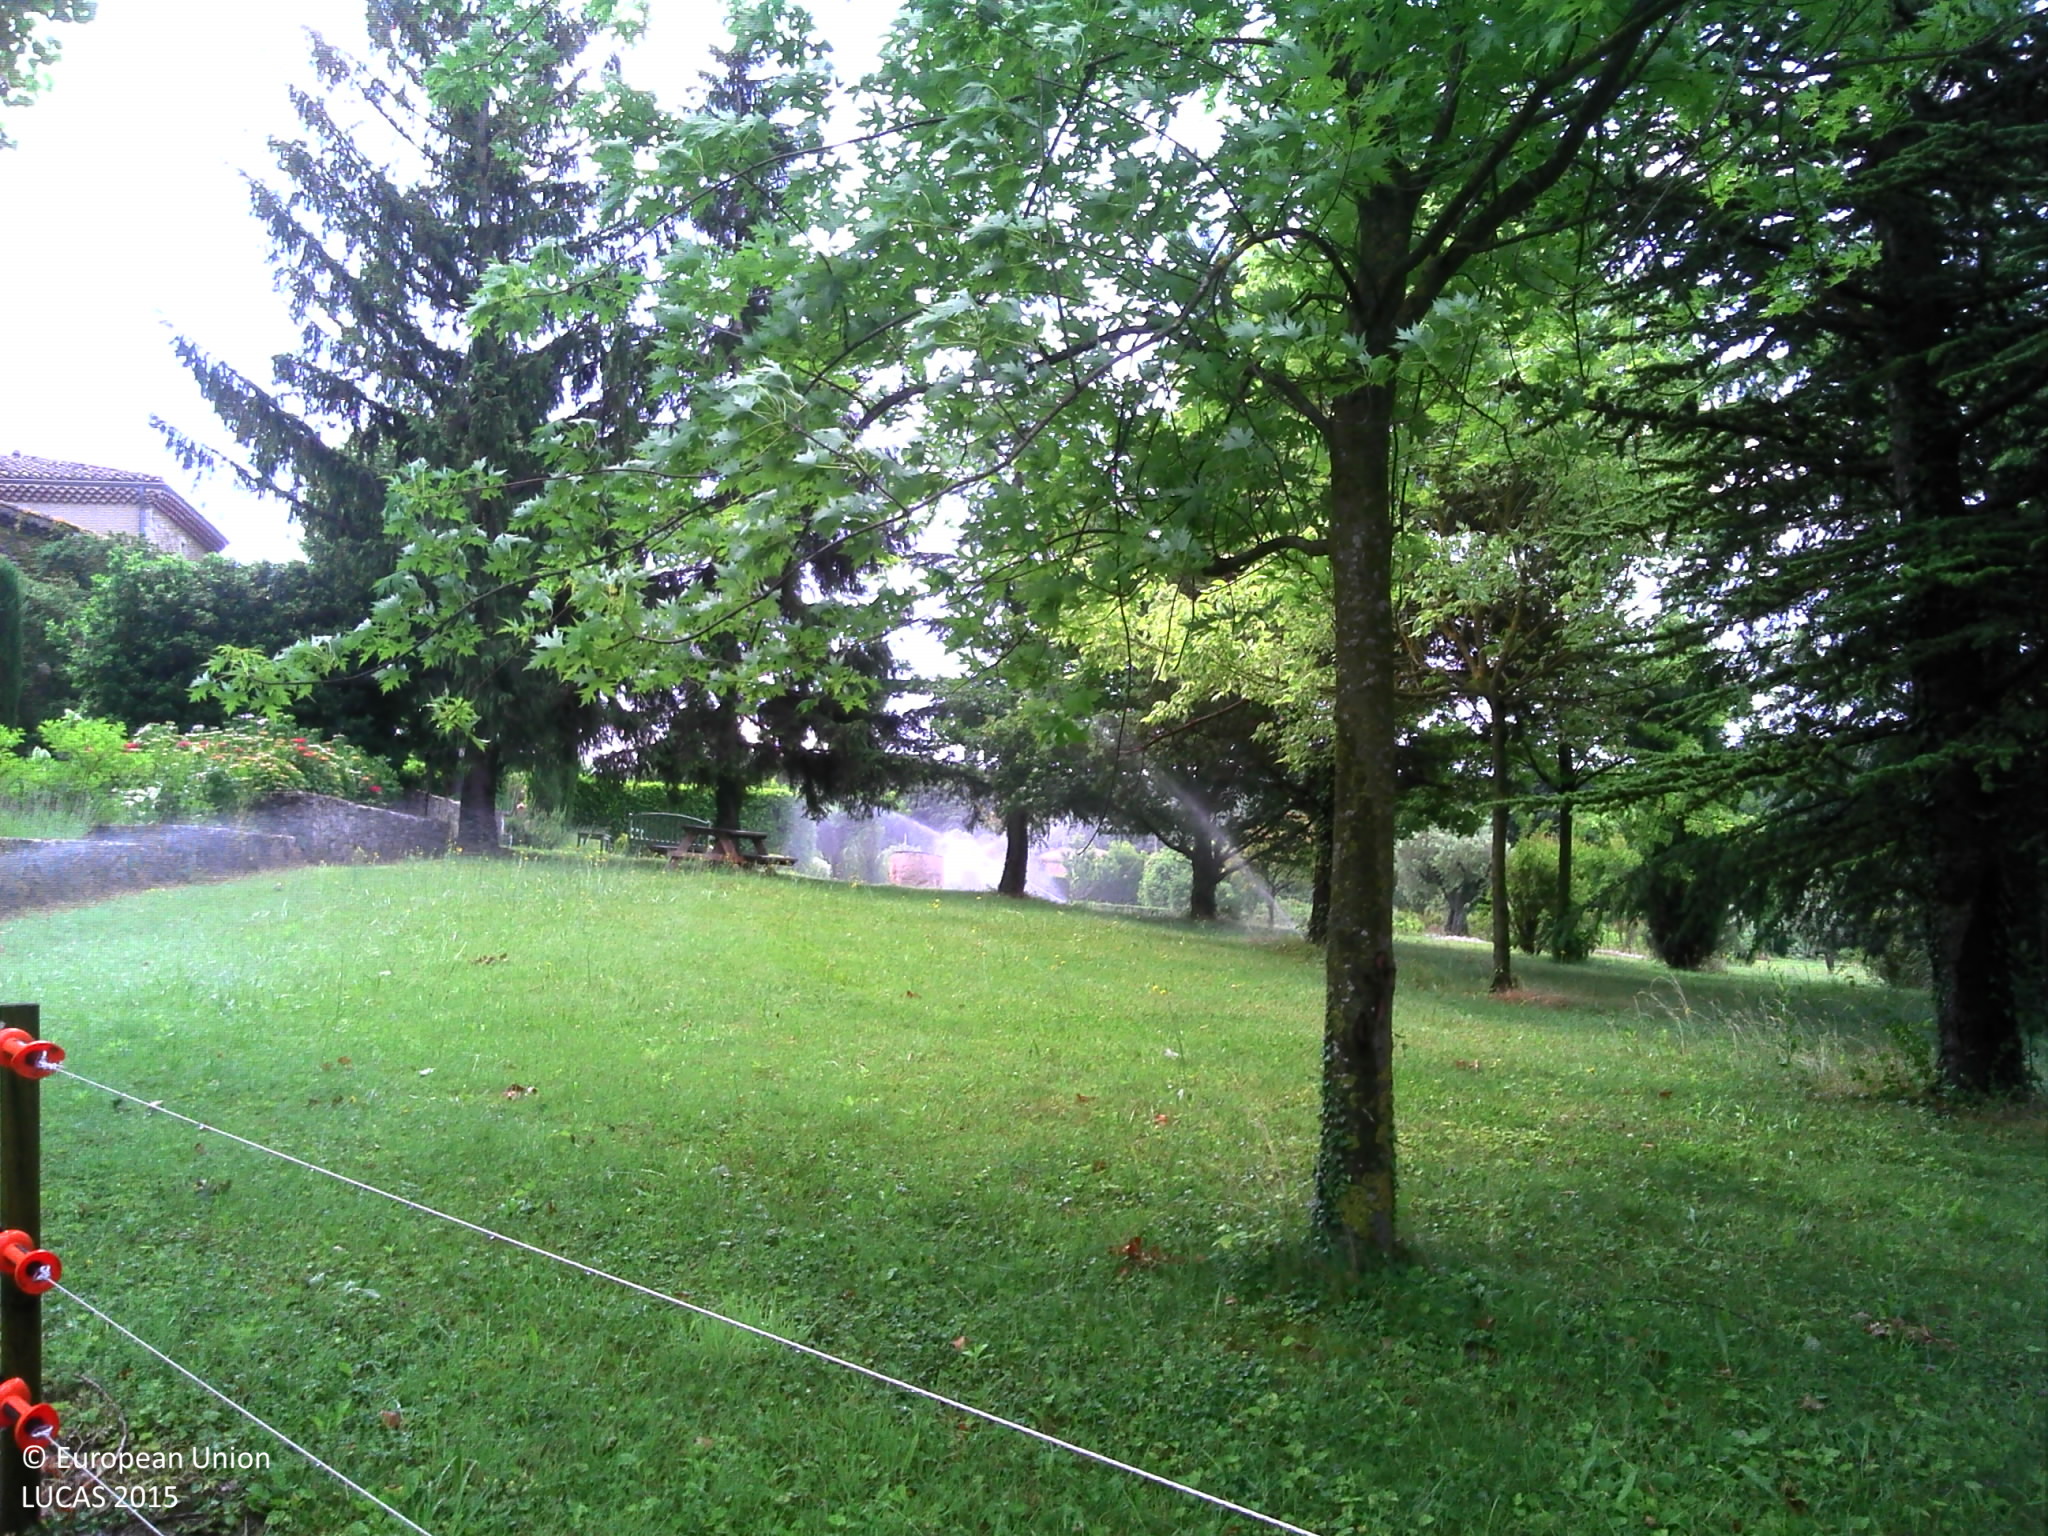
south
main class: Grassland
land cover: Grassland with sparse tree/shrub cover
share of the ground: > 75 %
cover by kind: herbaceous plants 95 %, broadleaved forest trees 5 %
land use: Residential
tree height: > 5 m
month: June
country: FR
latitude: 44.7919
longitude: 5.0386
